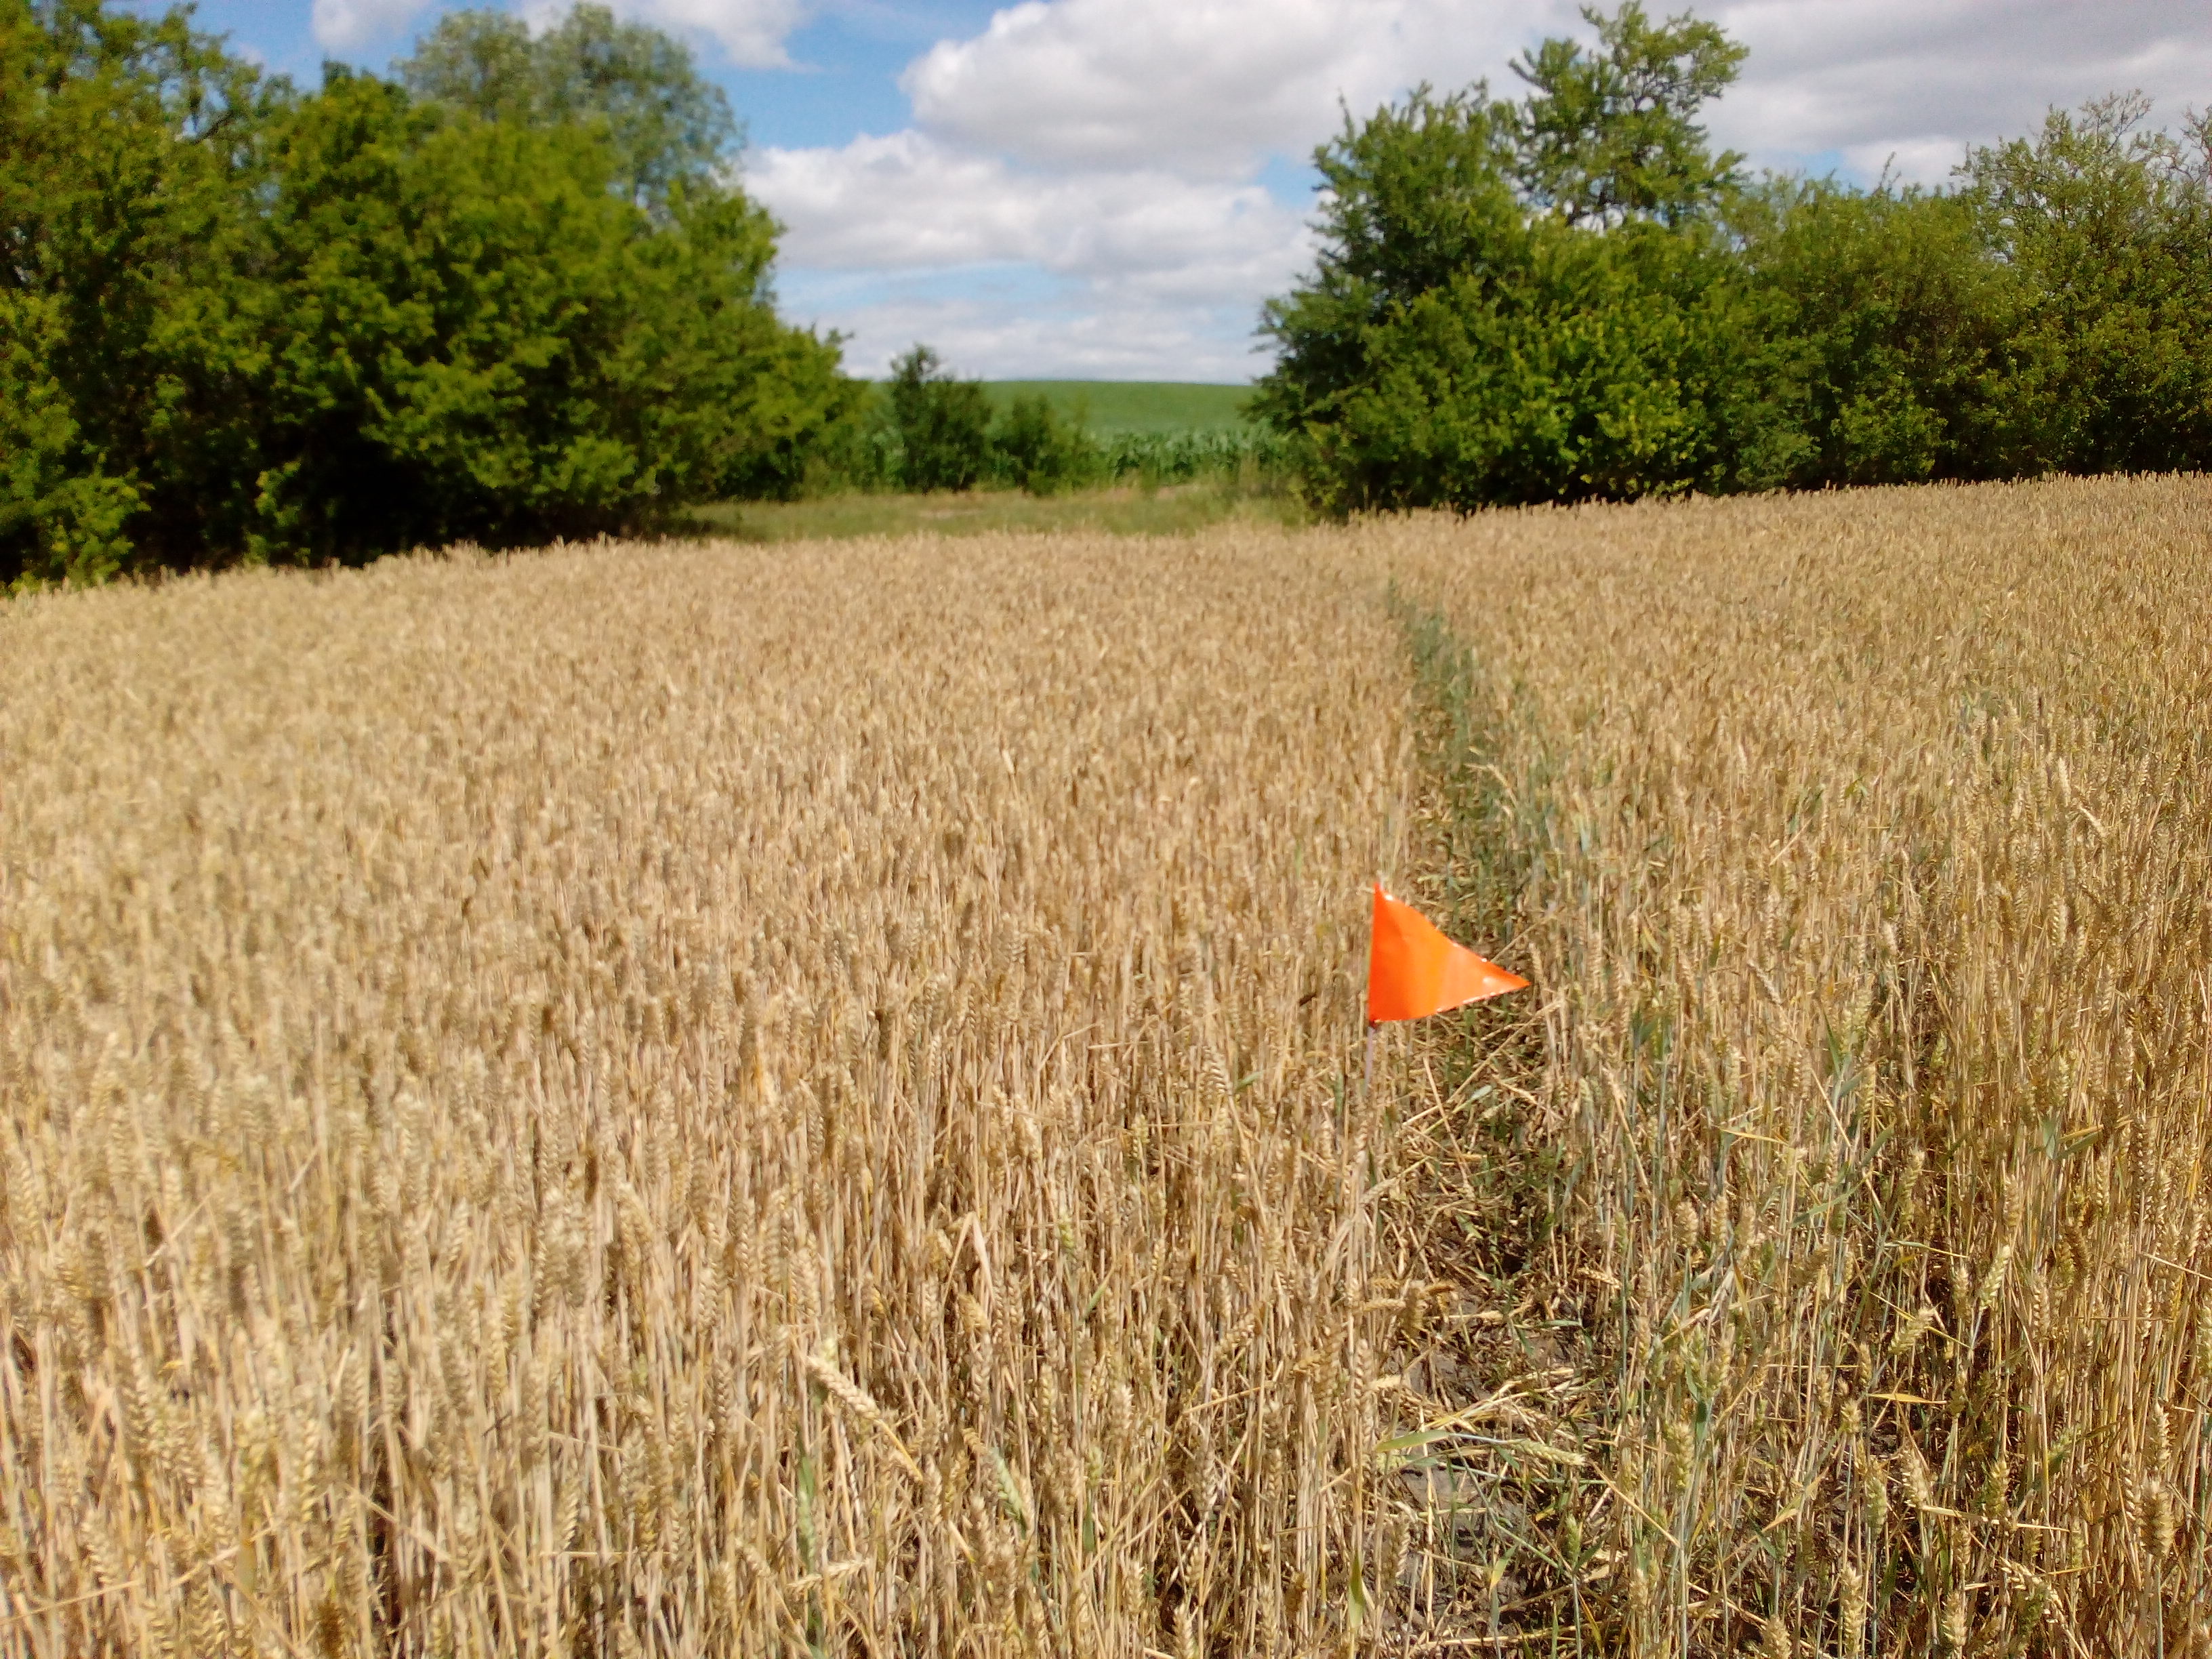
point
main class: Cropland
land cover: Common wheat
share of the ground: > 75 %
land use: Agriculture (excluding fallow land and kitchen gardens)
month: July
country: DE
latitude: 51.2038
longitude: 11.1018
